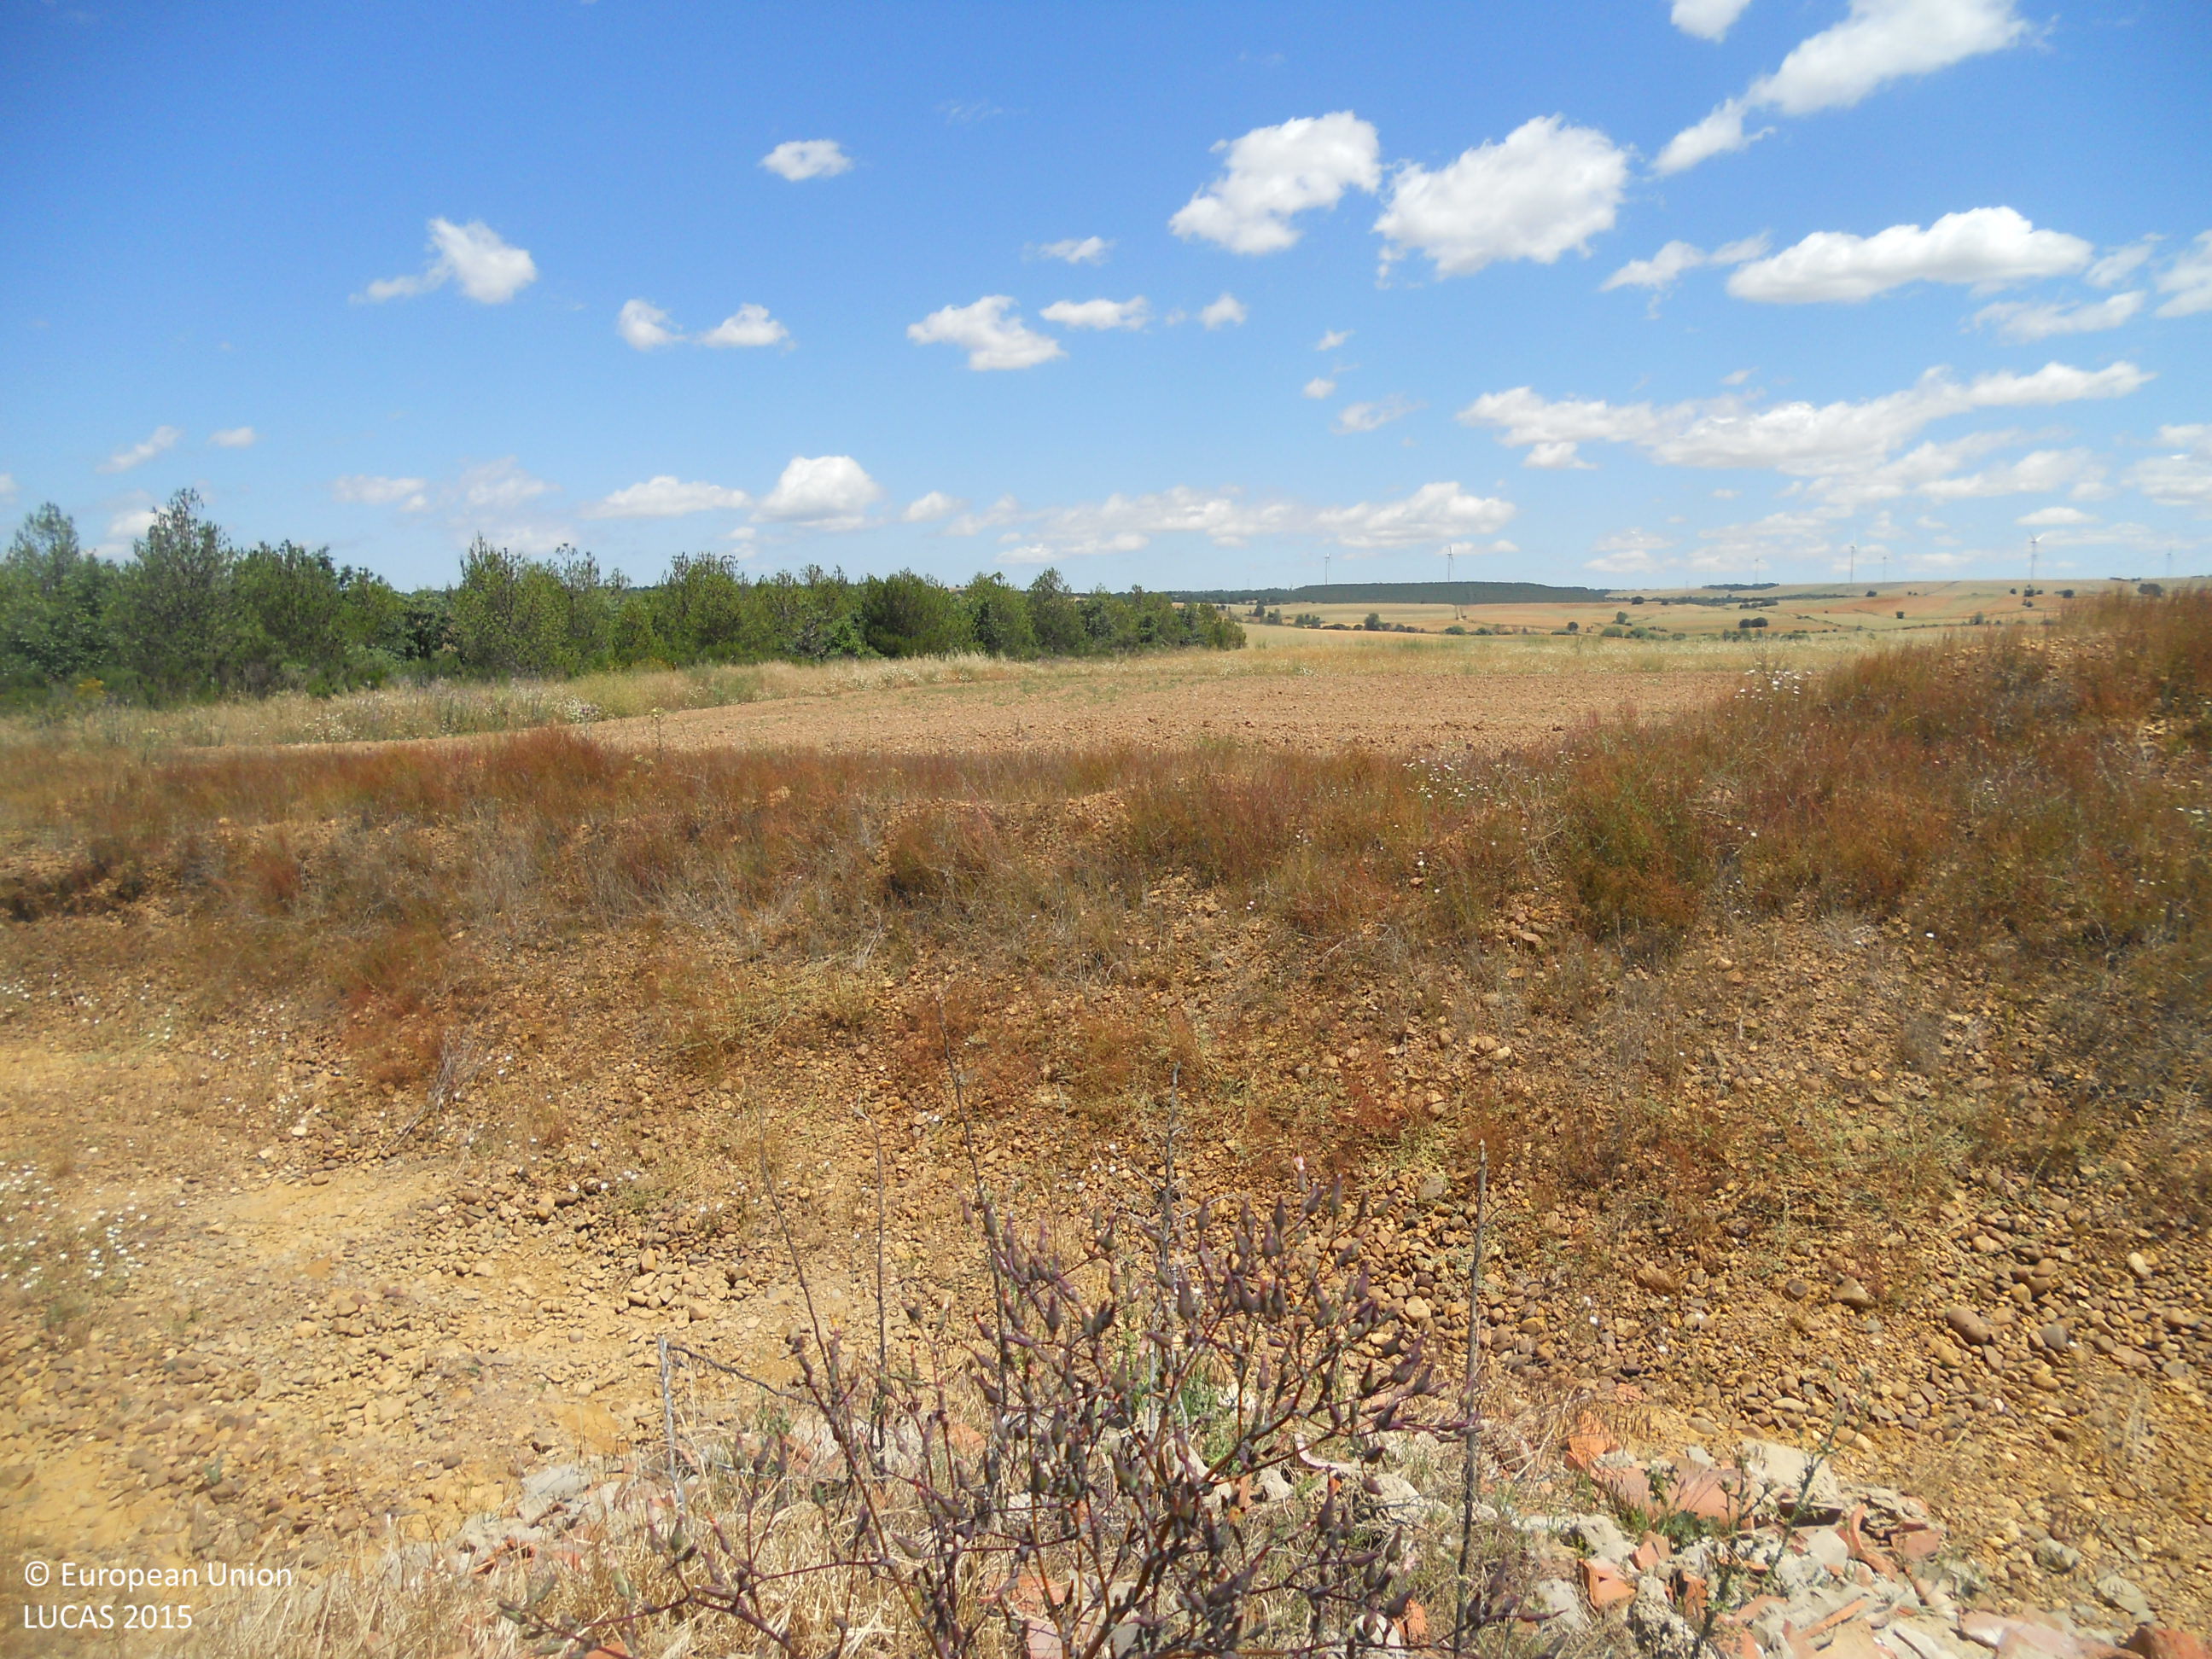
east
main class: Grassland
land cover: Grassland without tree/shrub cover
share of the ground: 50 - 75 %
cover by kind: herbaceous plants 70 %, unconsolidated bare surface 20 %
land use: Abandoned areas
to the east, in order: Grassland without tree/shrub cover; Grass margins; Other bare soil; Pine dominated coniferous woodland; Shrubland without tree cover; Common wheat
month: June
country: ES
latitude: 42.4851
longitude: -4.9870
